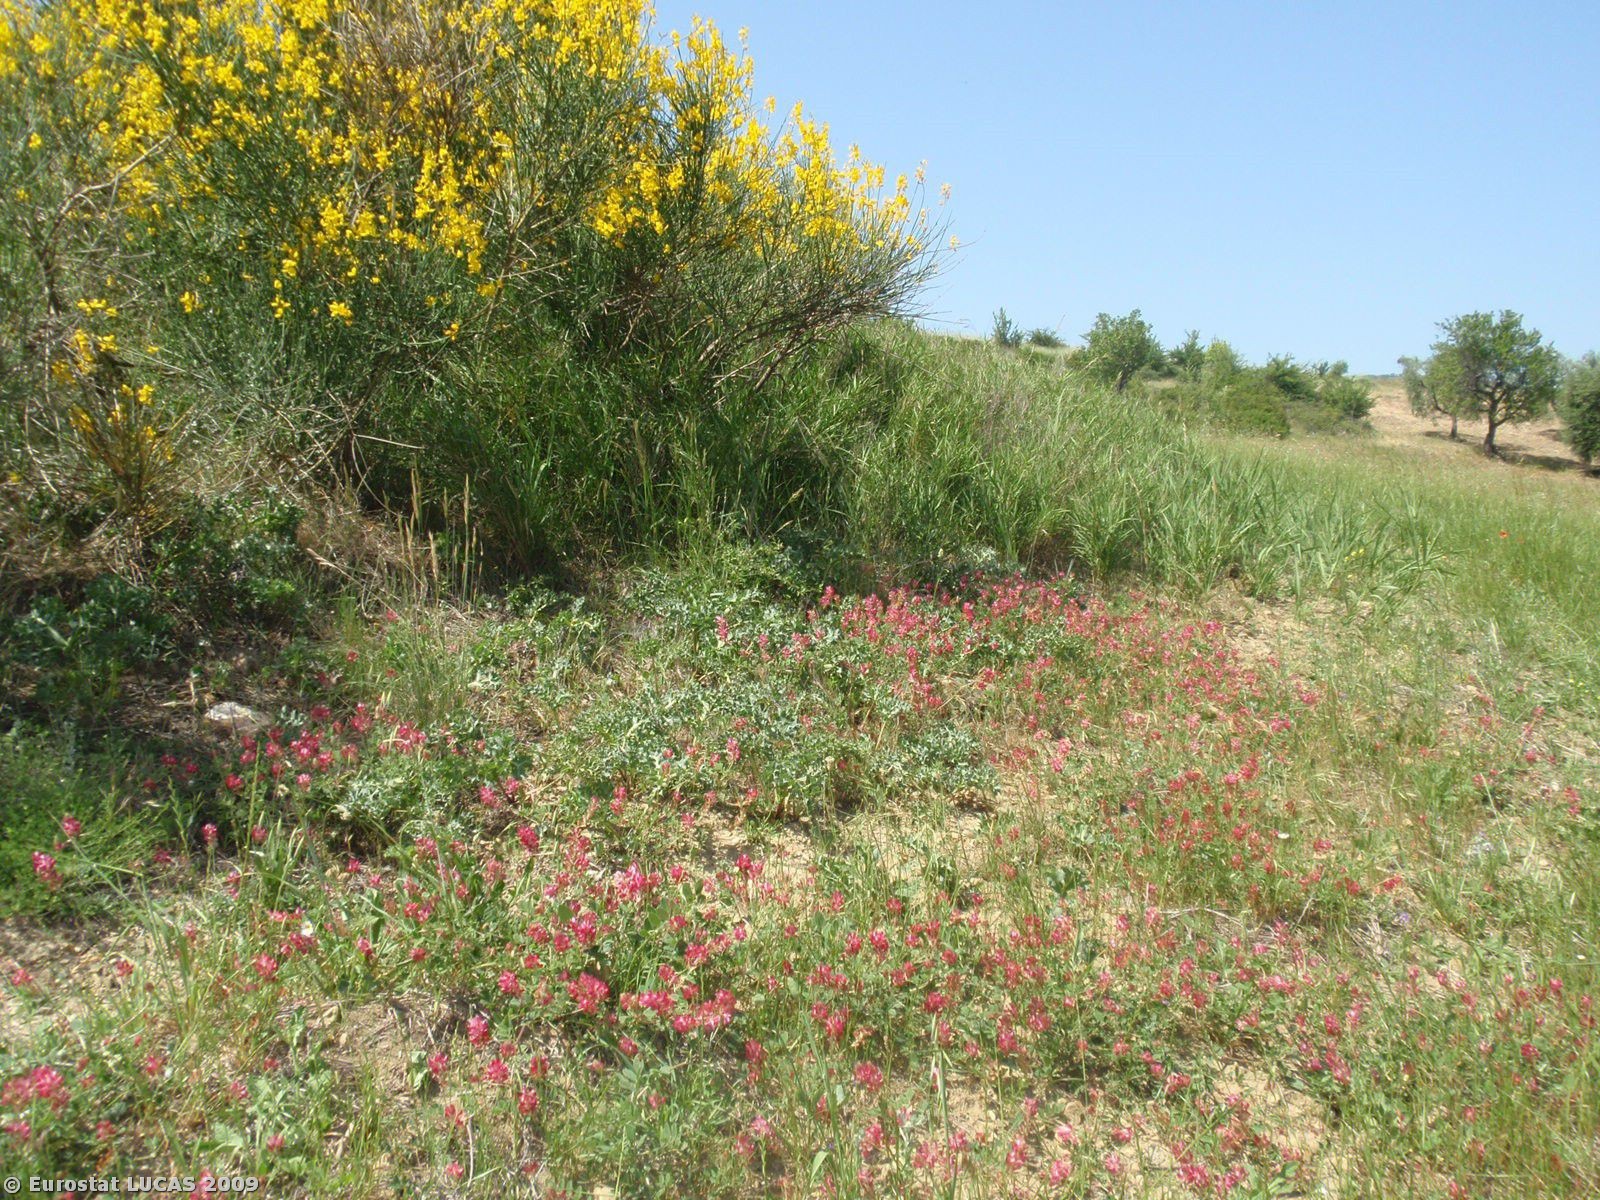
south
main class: Cropland
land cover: Mixed cereals for fodder
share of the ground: > 75 %
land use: Agriculture (excluding fallow land and kitchen gardens)
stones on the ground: < 10 %
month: May
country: IT
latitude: 40.3747
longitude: 16.2767
